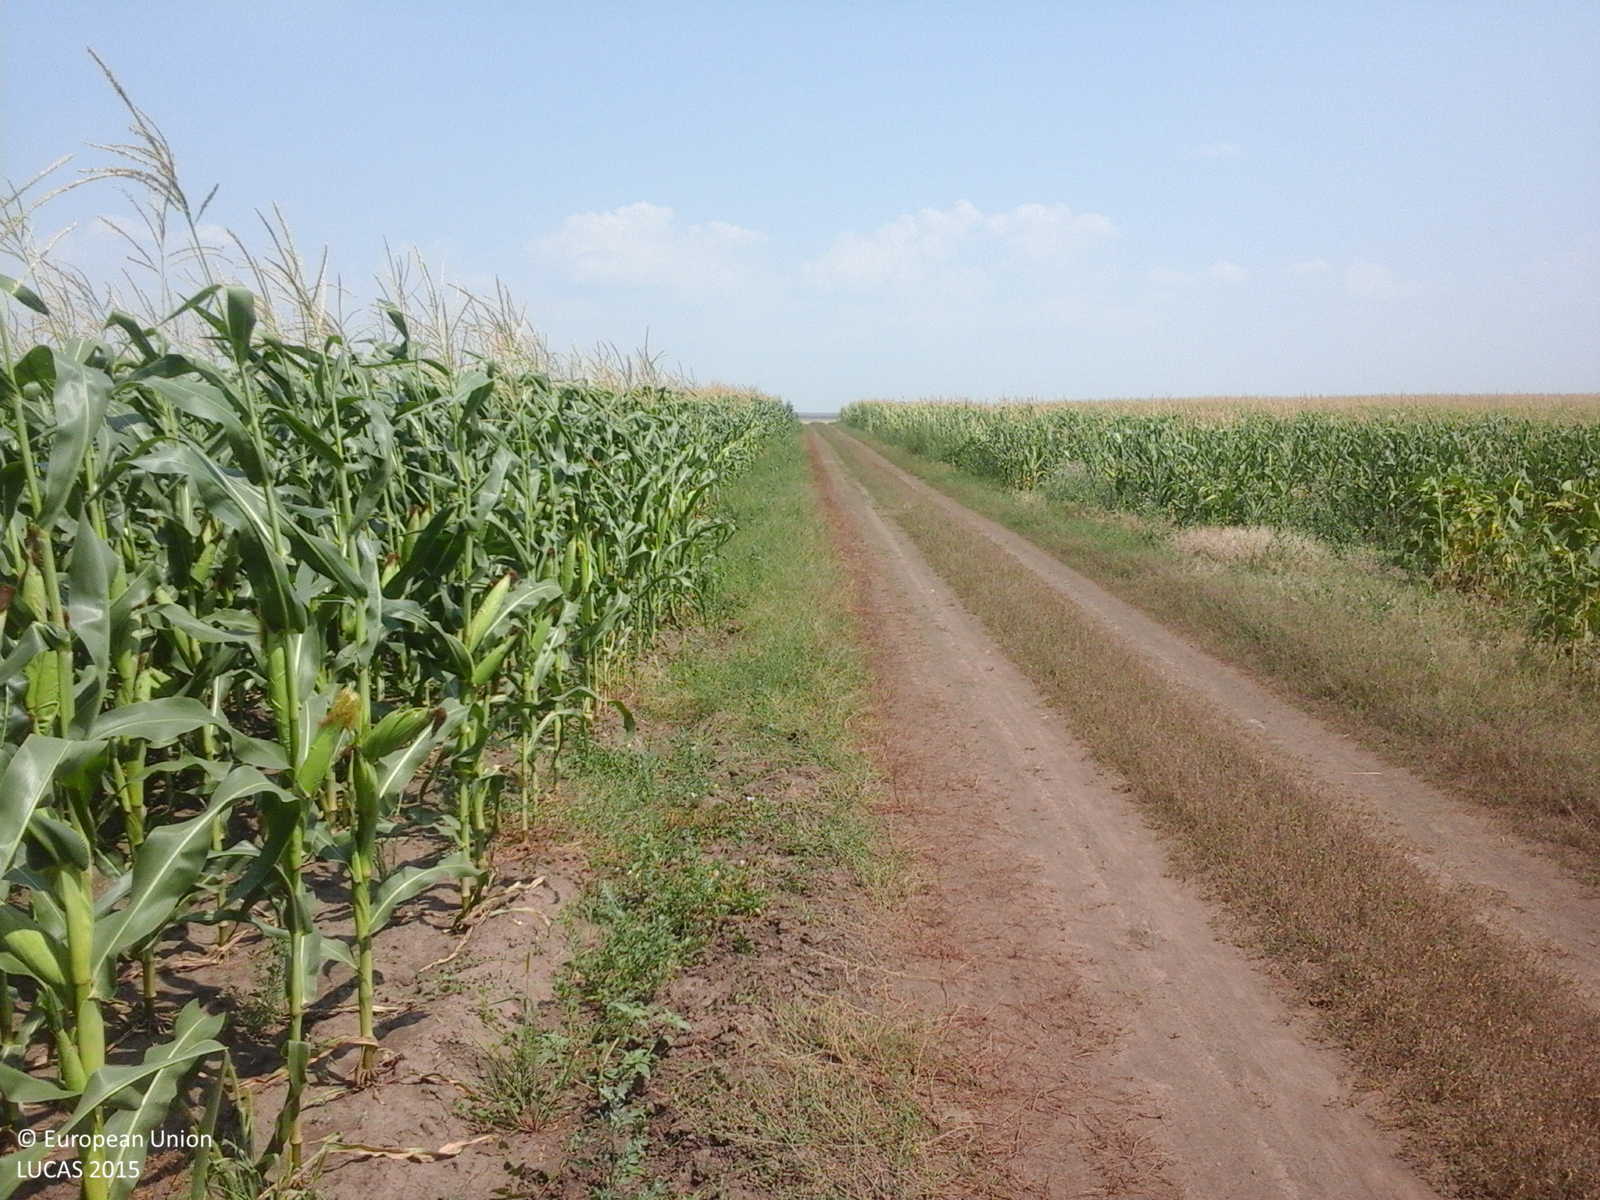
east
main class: Cropland
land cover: Maize
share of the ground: > 75 %
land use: Agriculture (excluding fallow land and kitchen gardens)
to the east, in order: Maize
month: July
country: RO
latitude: 45.9339
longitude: 27.5576
